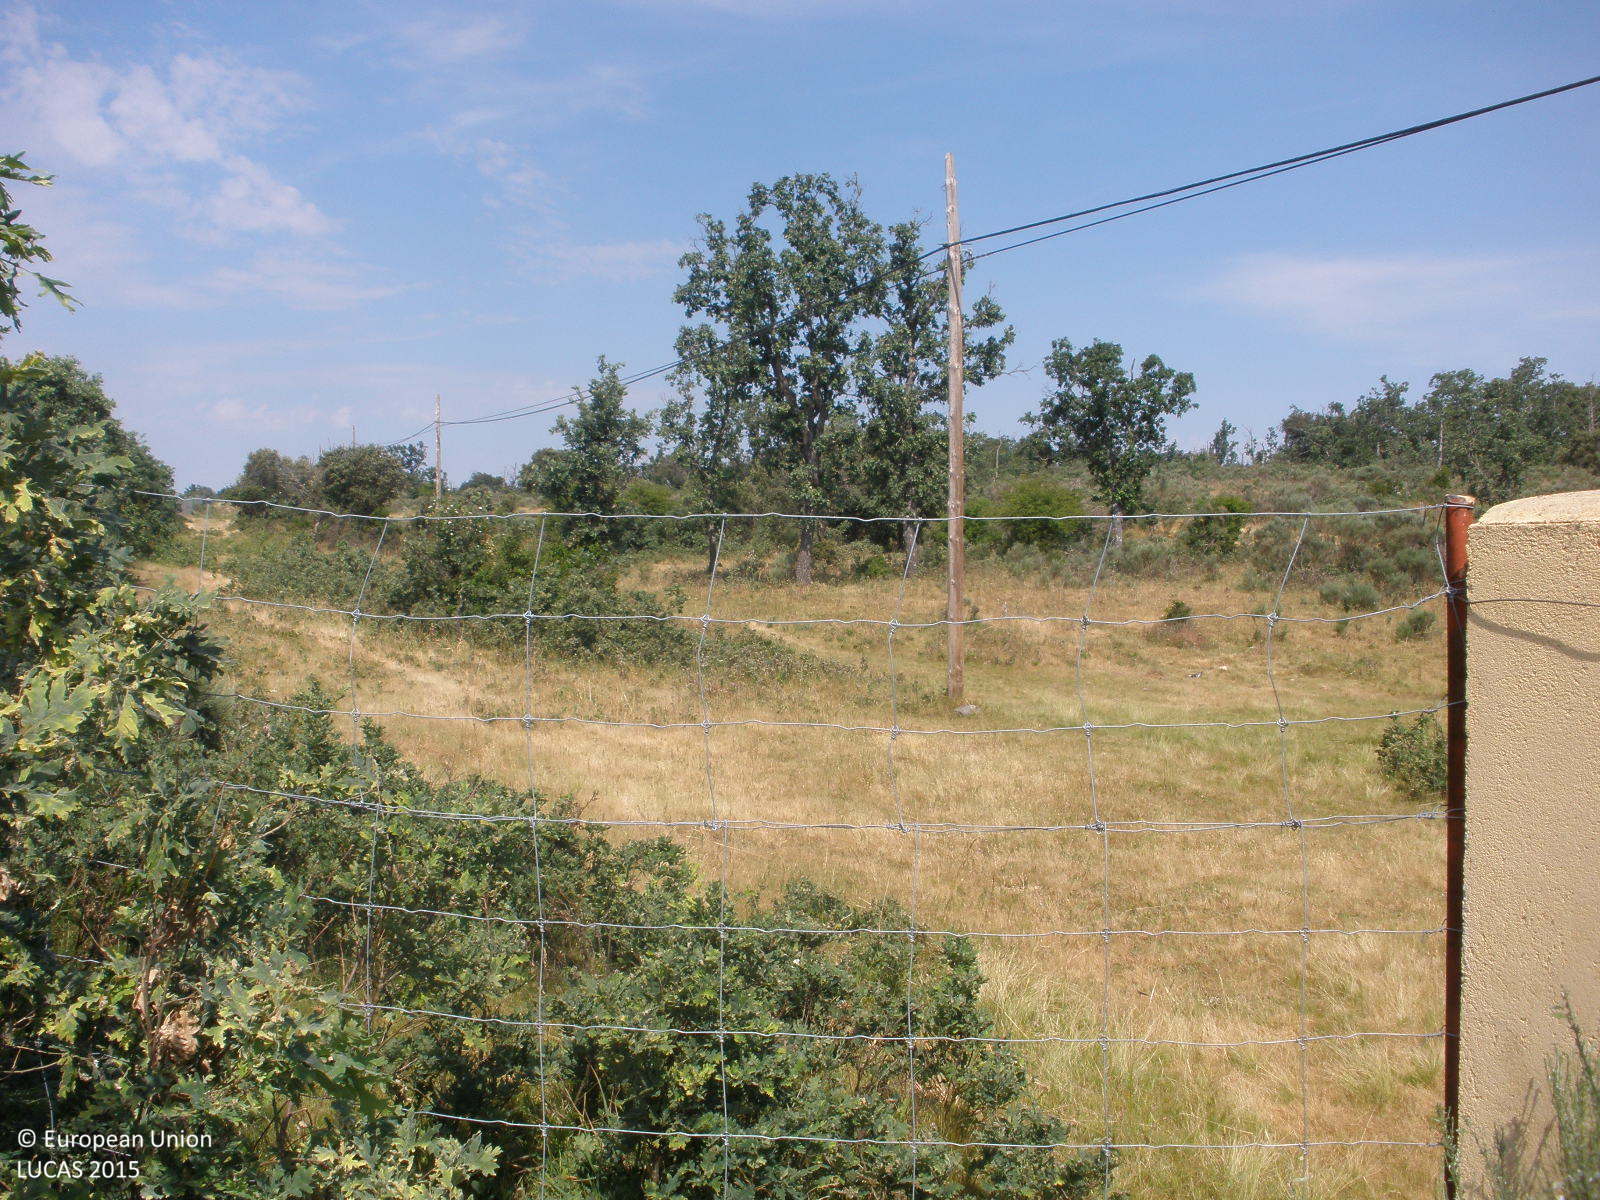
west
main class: Shrubland
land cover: Shrubland with sparse tree cover
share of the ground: > 75 %
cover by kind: shrubs 70 %, herbaceous plants 25 %, broadleaved forest trees 5 %
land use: Agriculture (excluding fallow land and kitchen gardens)
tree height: > 5 m
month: June
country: ES
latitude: 40.6400
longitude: -5.9826
